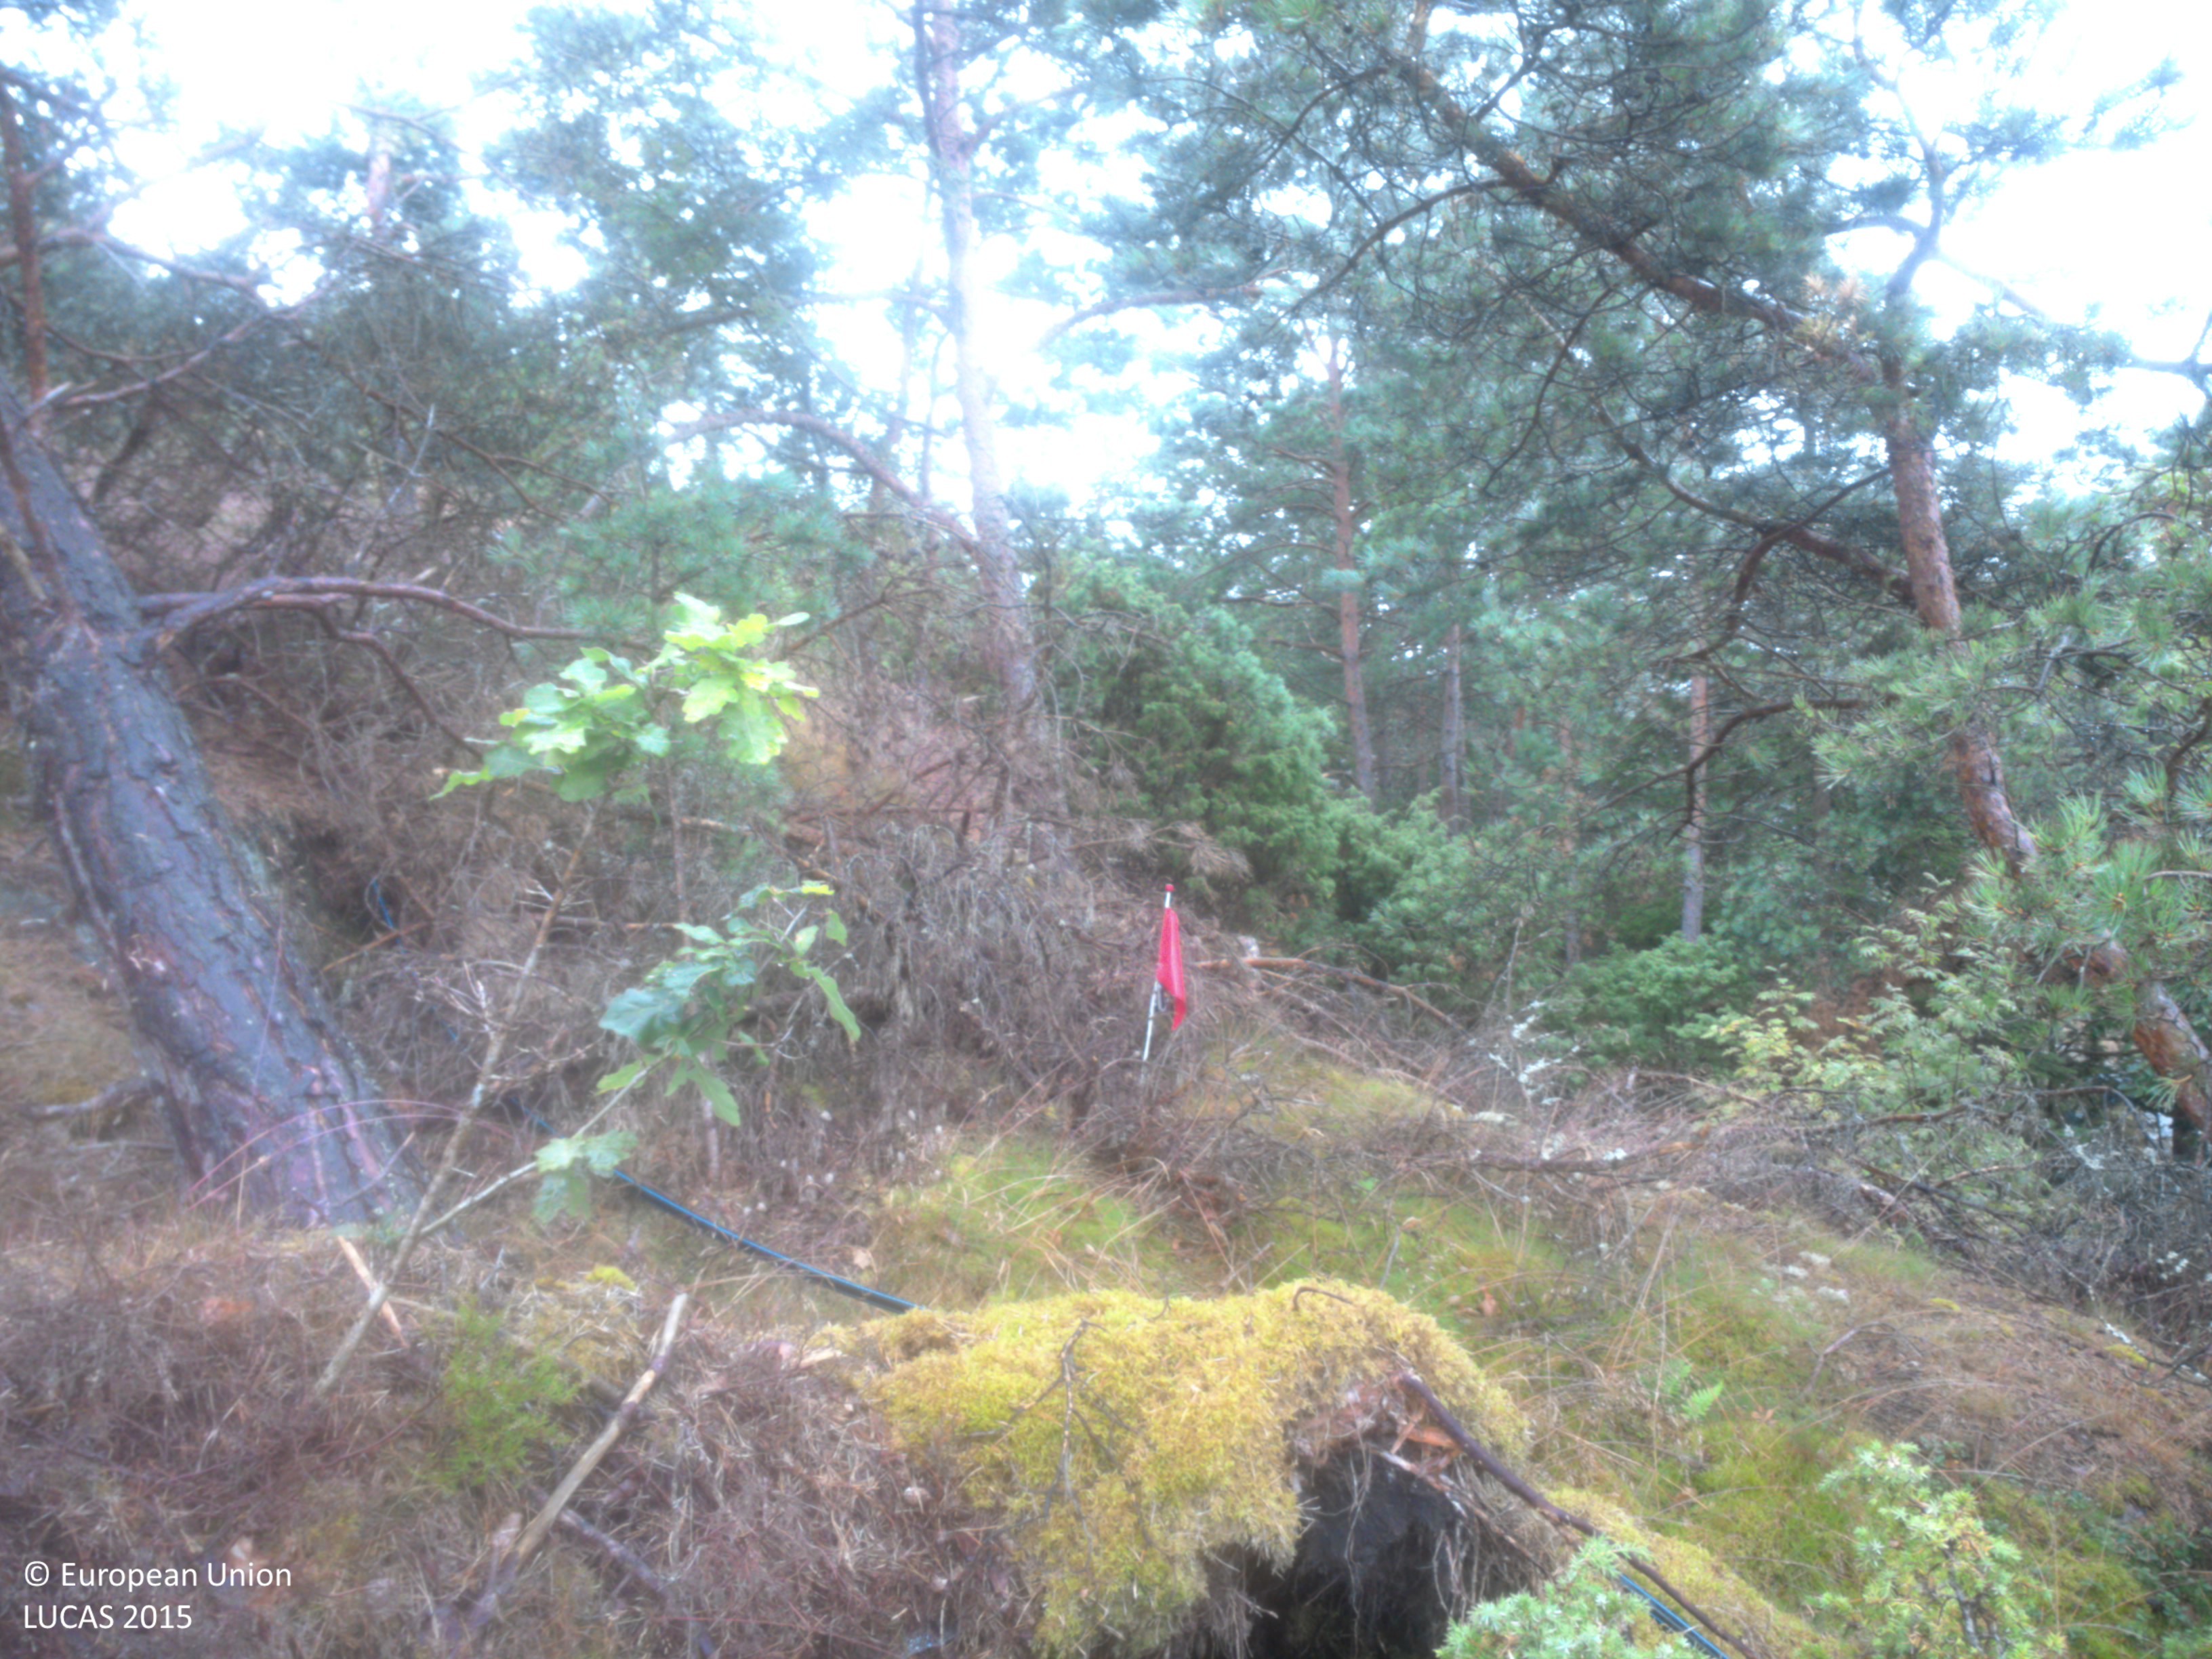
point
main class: Woodland
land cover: Pine dominated coniferous woodland
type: boreal forest
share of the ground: 25 - 50 %
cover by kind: coniferous forest trees 45 %, shrubs 25 %, herbaceous plants 10 %, lichens and mosses 10 %, consolidated bare surface 10 %
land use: Amenities, museums, leisure
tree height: > 5 m
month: July
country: SE
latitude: 58.1002
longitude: 11.7442
